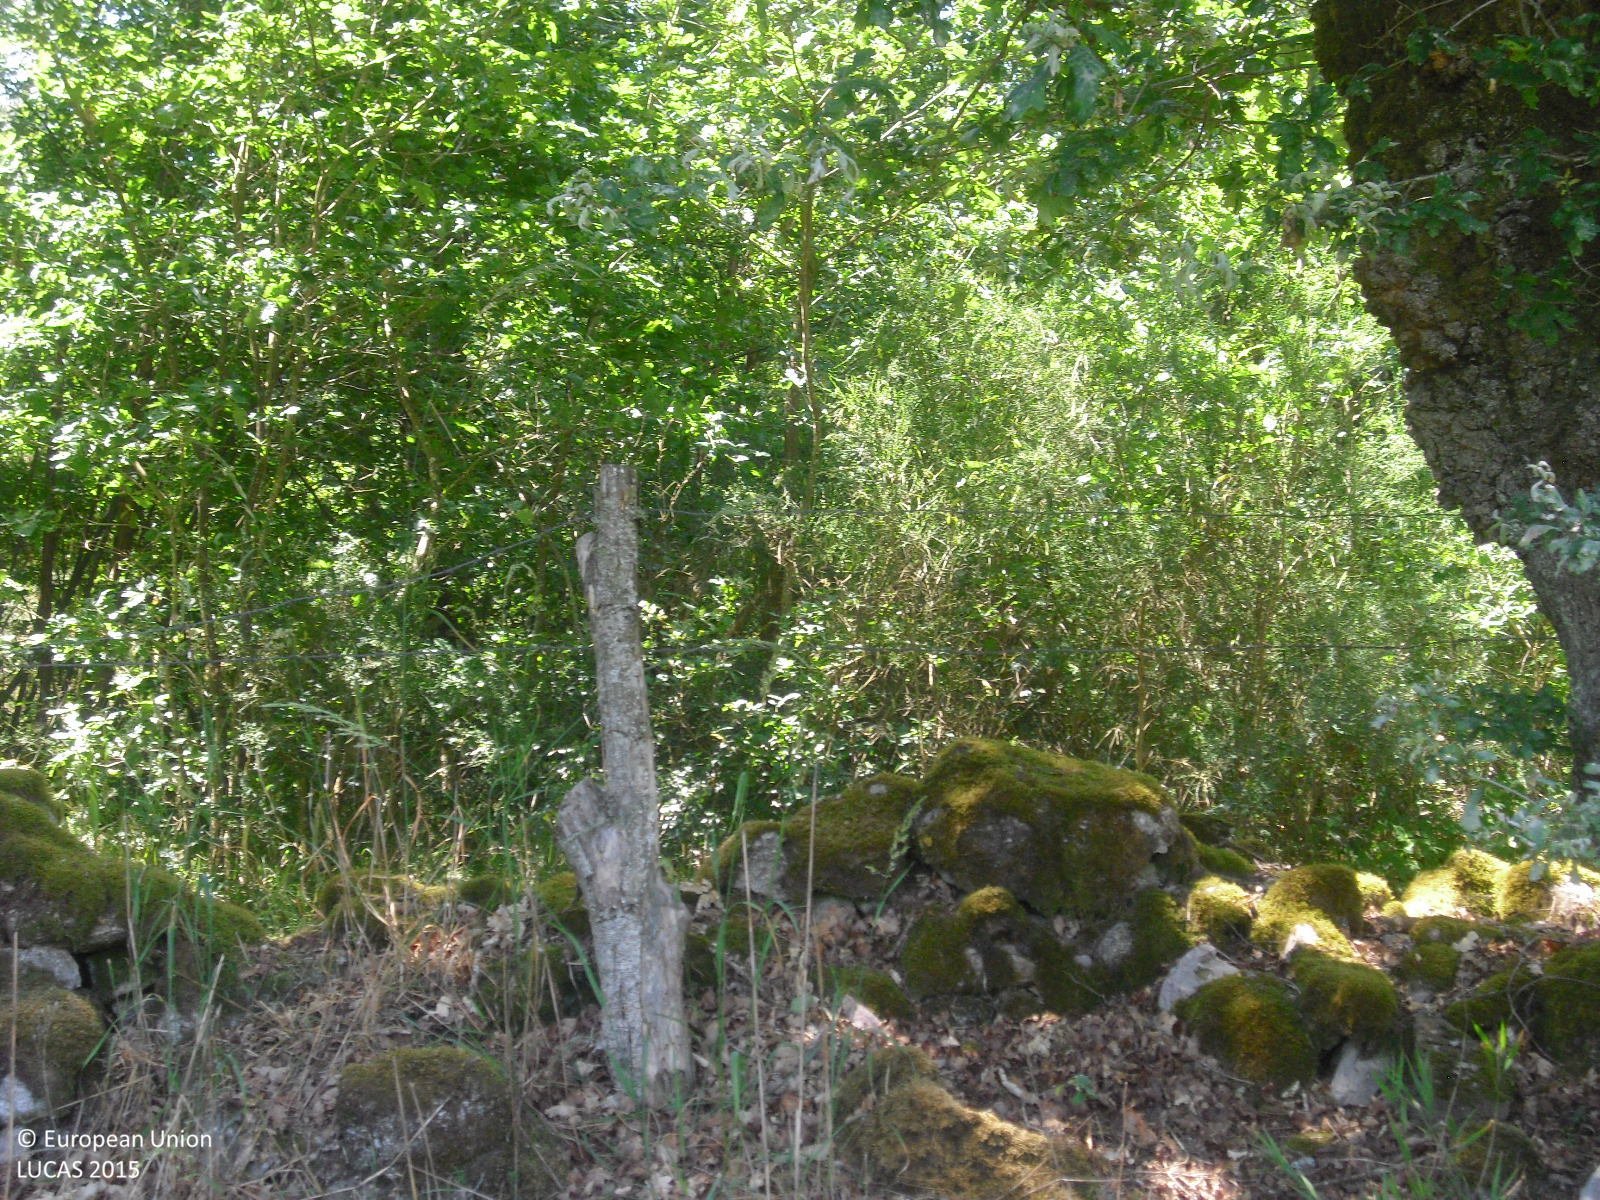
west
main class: Cropland
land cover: Maize
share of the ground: 25 - 50 %
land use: Agriculture (excluding fallow land and kitchen gardens)
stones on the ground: < 10 %
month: June
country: ES
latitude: 42.6526
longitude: -7.7785
